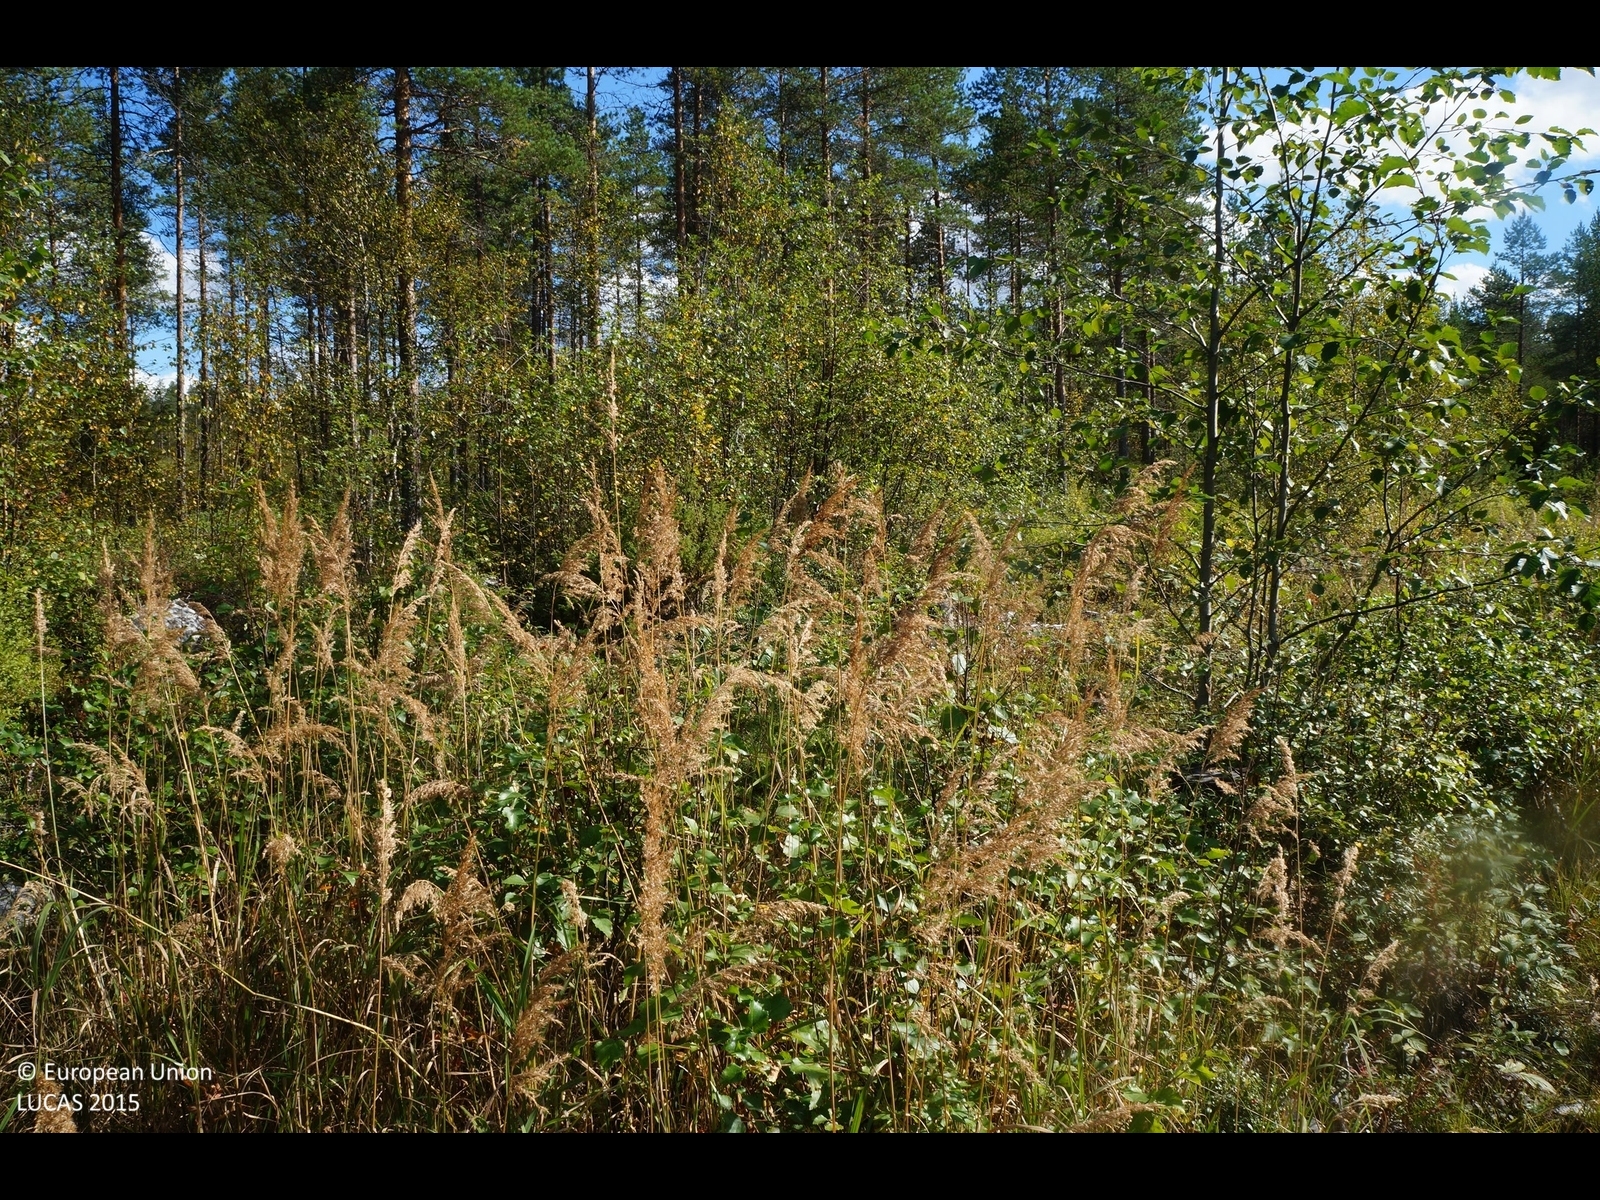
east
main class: Woodland
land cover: Broadleaved woodland
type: boreal forest
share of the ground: 25 - 50 %
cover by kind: shrubs 60 %, broadleaved forest trees 25 %, lichens and mosses 10 %, herbaceous plants 5 %
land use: Forestry
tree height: < 5 m
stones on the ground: < 10 %
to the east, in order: Broadleaved woodland; Ditches and canals; Pine dominated coniferous woodland; Ditches and canals; Pine dominated coniferous woodland; Broadleaved woodland; Ditches and canals; Broadleaved woodland; Shrubland with sparse tree cover; Pine dominated coniferous woodland
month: September
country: FI
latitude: 63.9629
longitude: 24.3448
